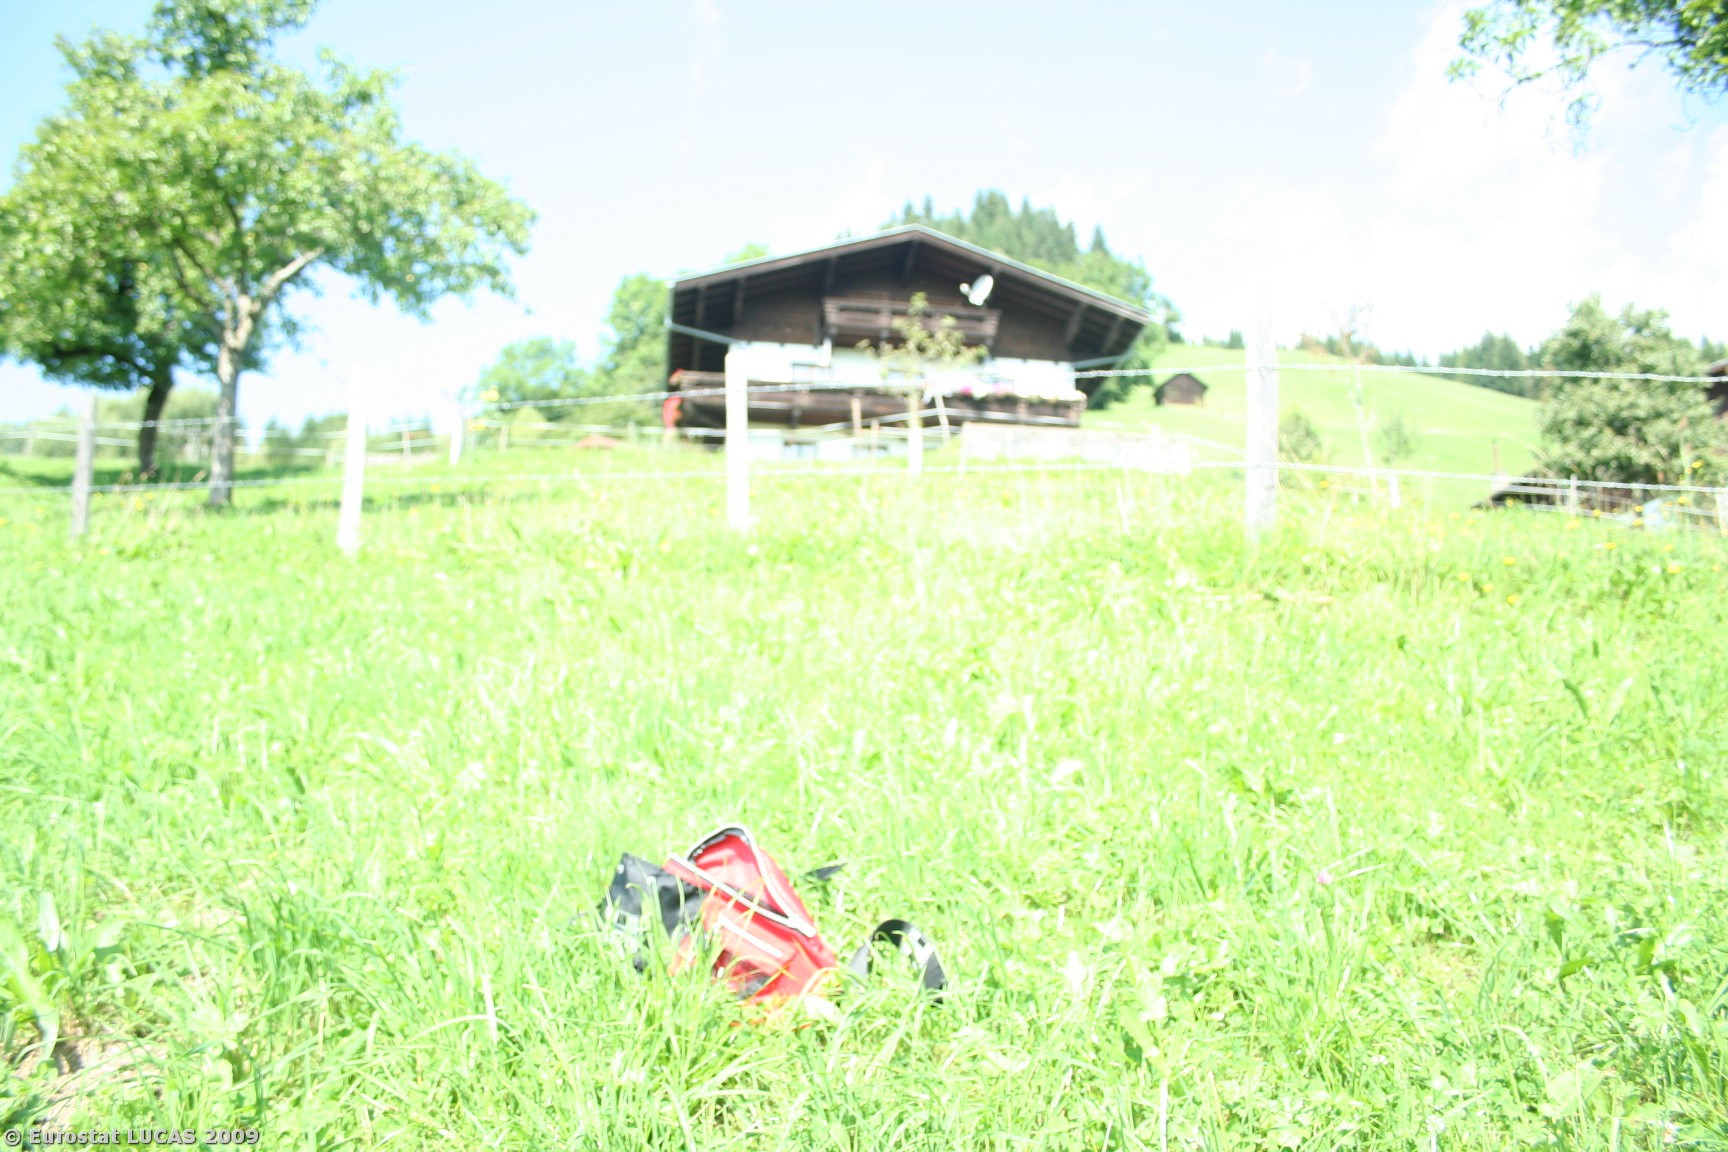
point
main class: Grassland
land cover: Grassland without tree/shrub cover
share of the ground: > 75 %
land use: Agriculture (excluding fallow land and kitchen gardens)
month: August
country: AT
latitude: 47.3669
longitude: 13.1894
